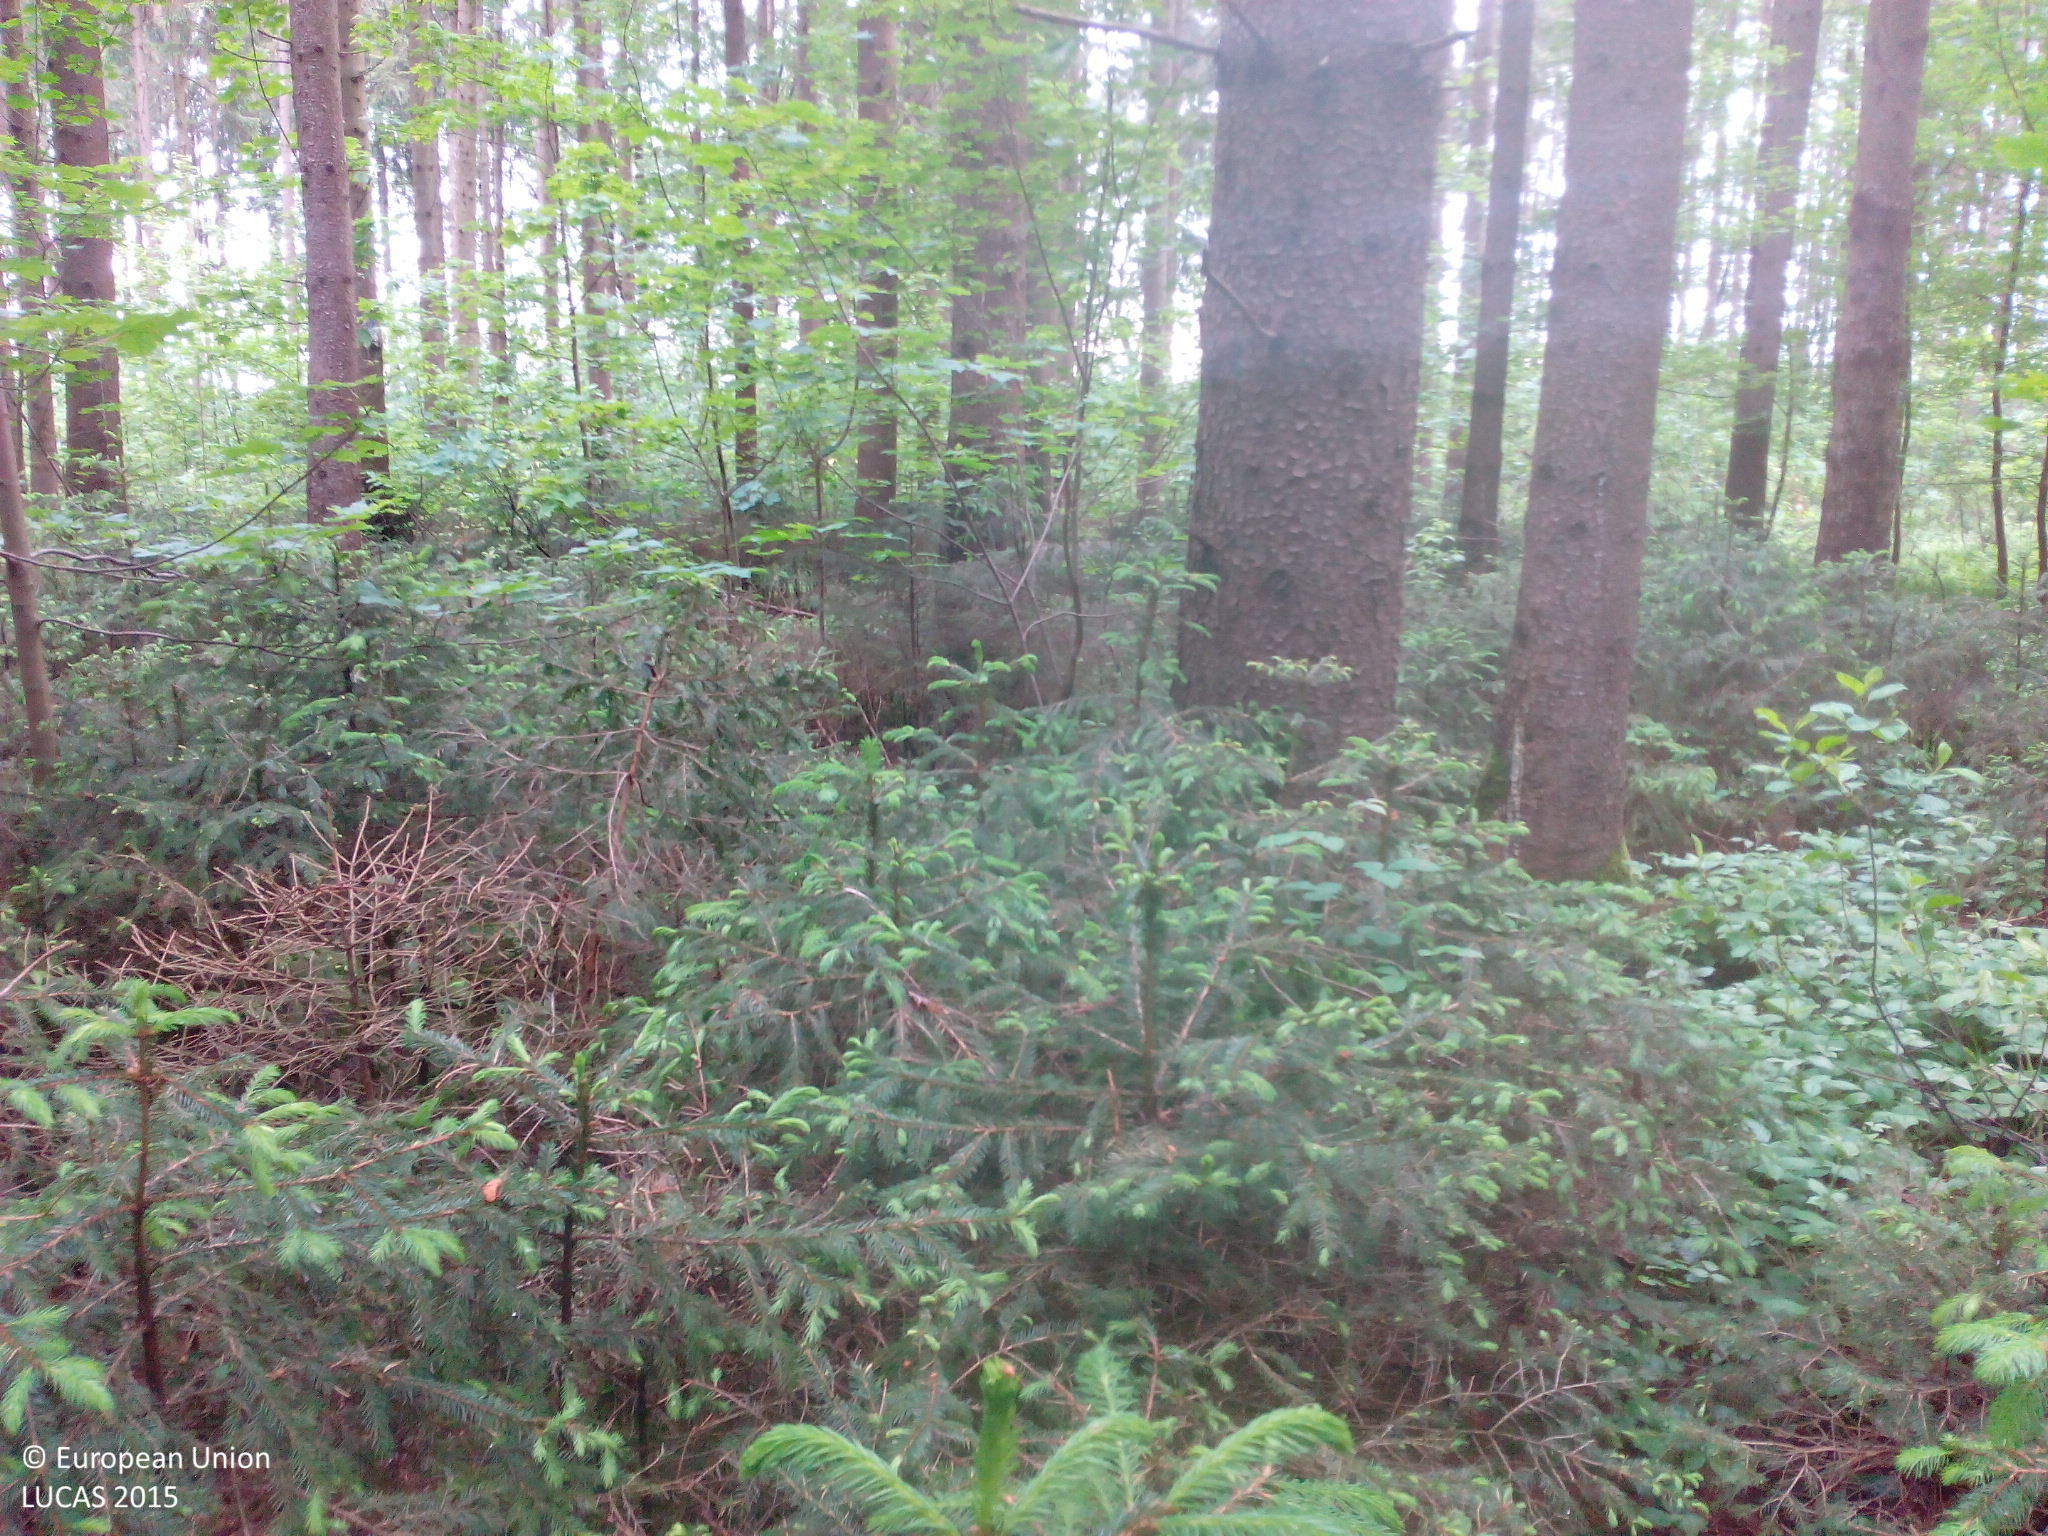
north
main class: Woodland
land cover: Spruce dominated coniferous woodland
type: hemiboreal forest and nemoral coniferous forest and mixed broadleaved-coniferous forest
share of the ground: > 75 %
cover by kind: coniferous forest trees 80 %, broadleaved forest trees 15 %, shrubs 5 %
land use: Forestry
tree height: > 5 m
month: May
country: DE
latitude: 48.0250
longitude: 9.6382
